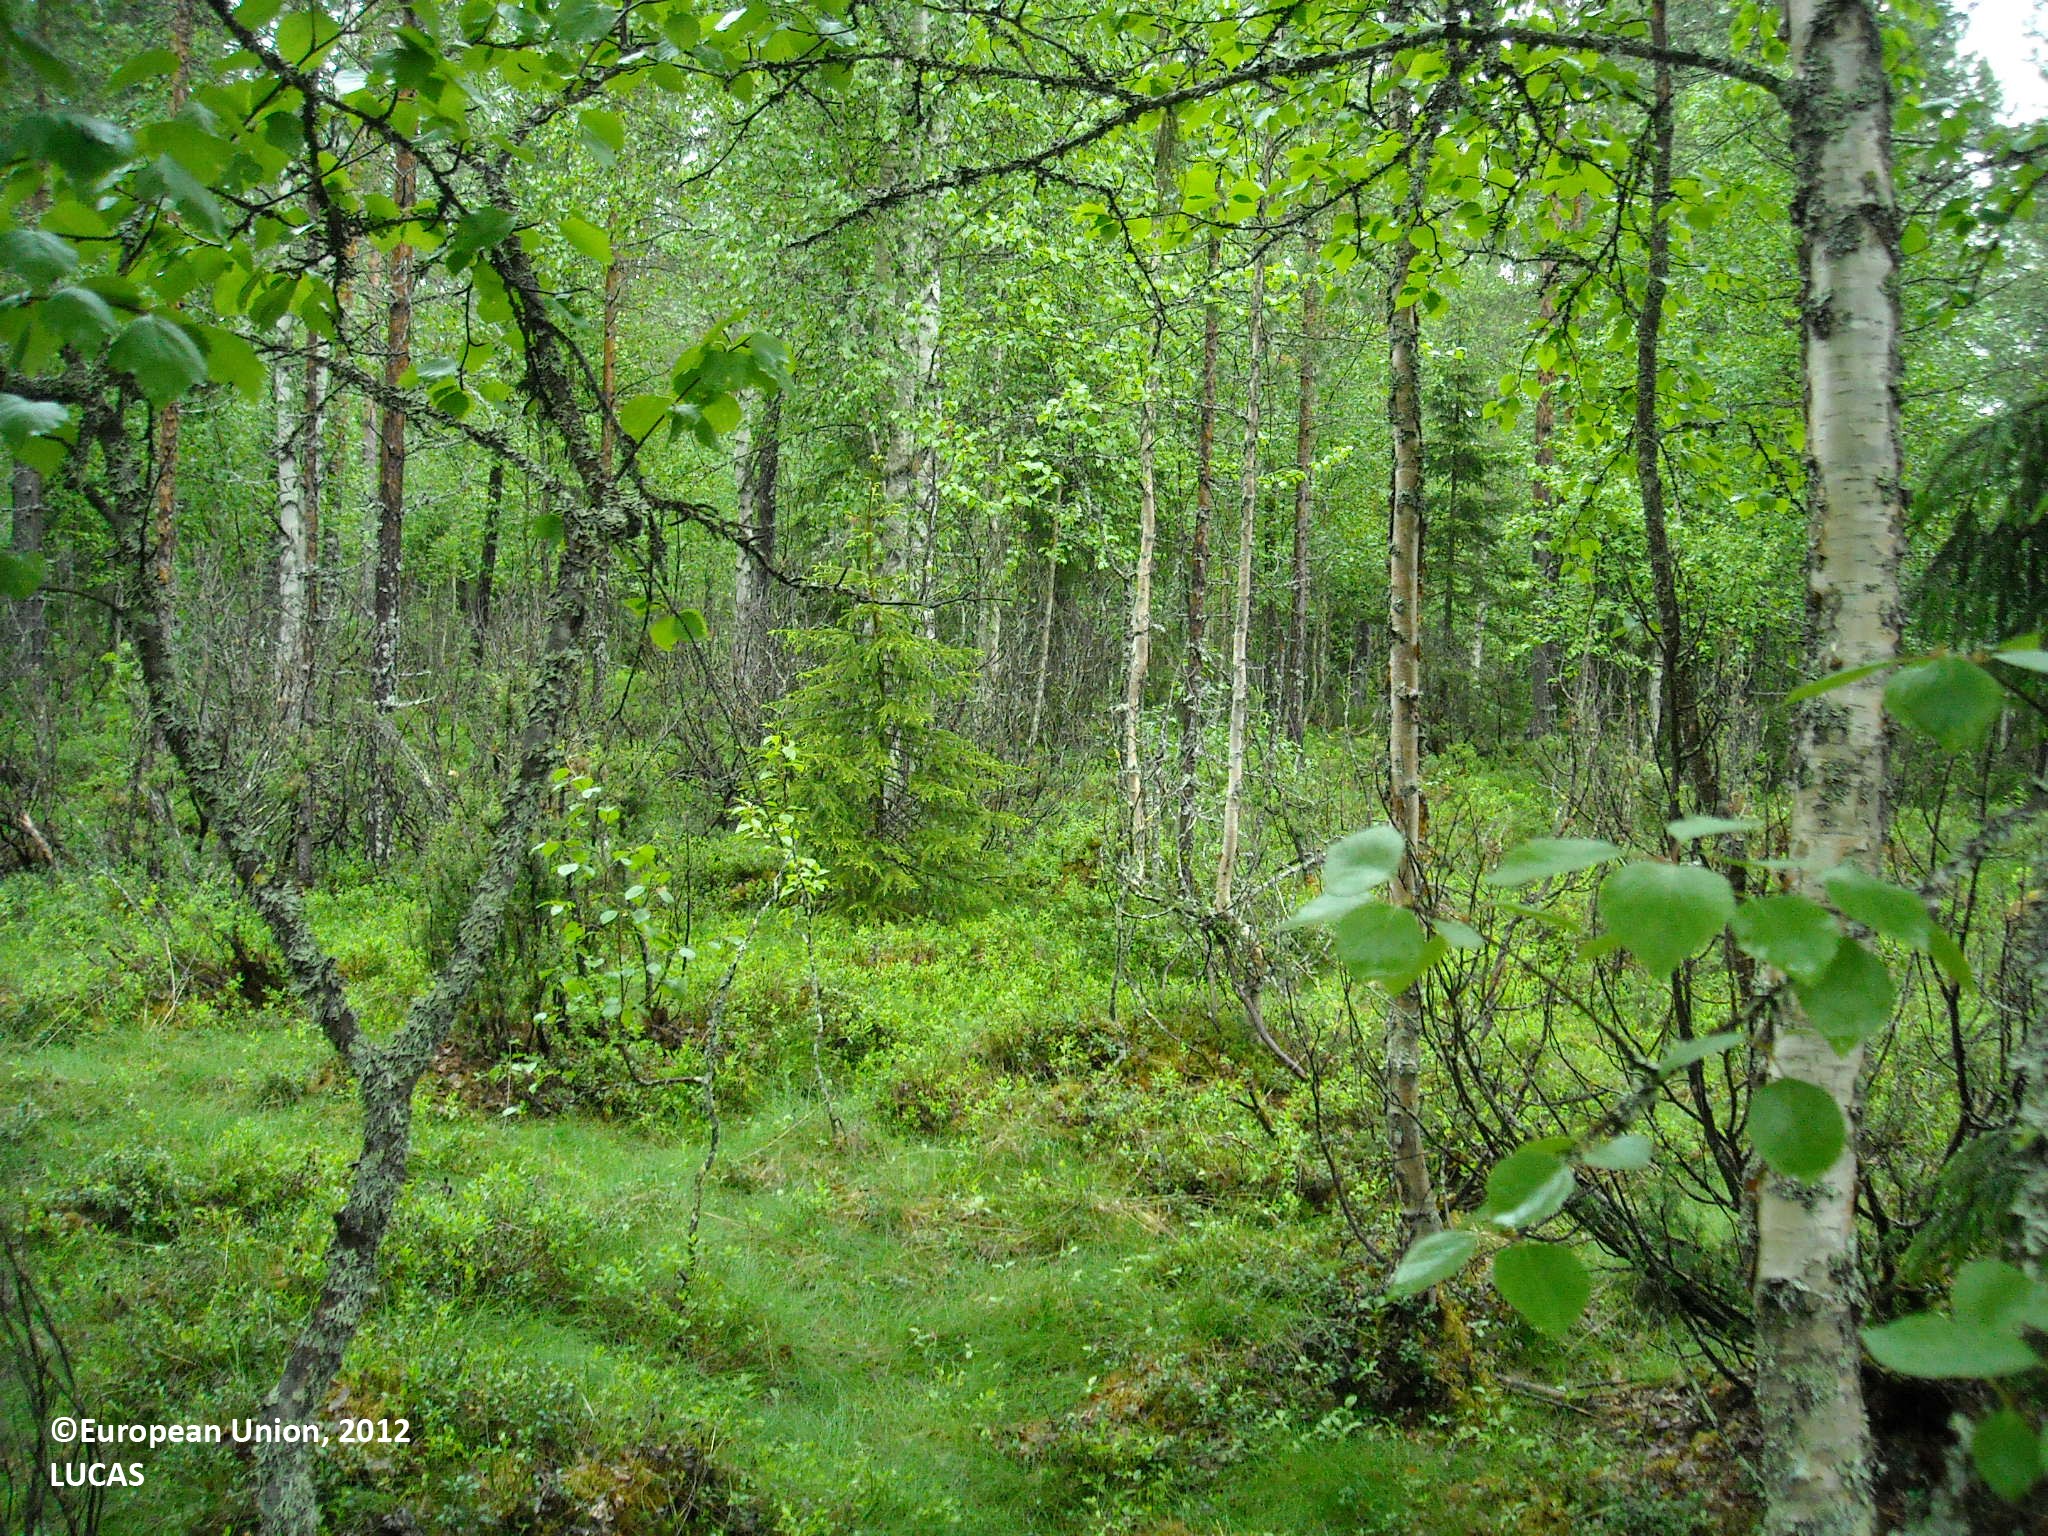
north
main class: Woodland
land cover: Other mixed woodland
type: boreal forest
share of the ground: > 75 %
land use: Forestry
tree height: > 5 m
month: June
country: FI
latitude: 65.4335
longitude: 27.9276
